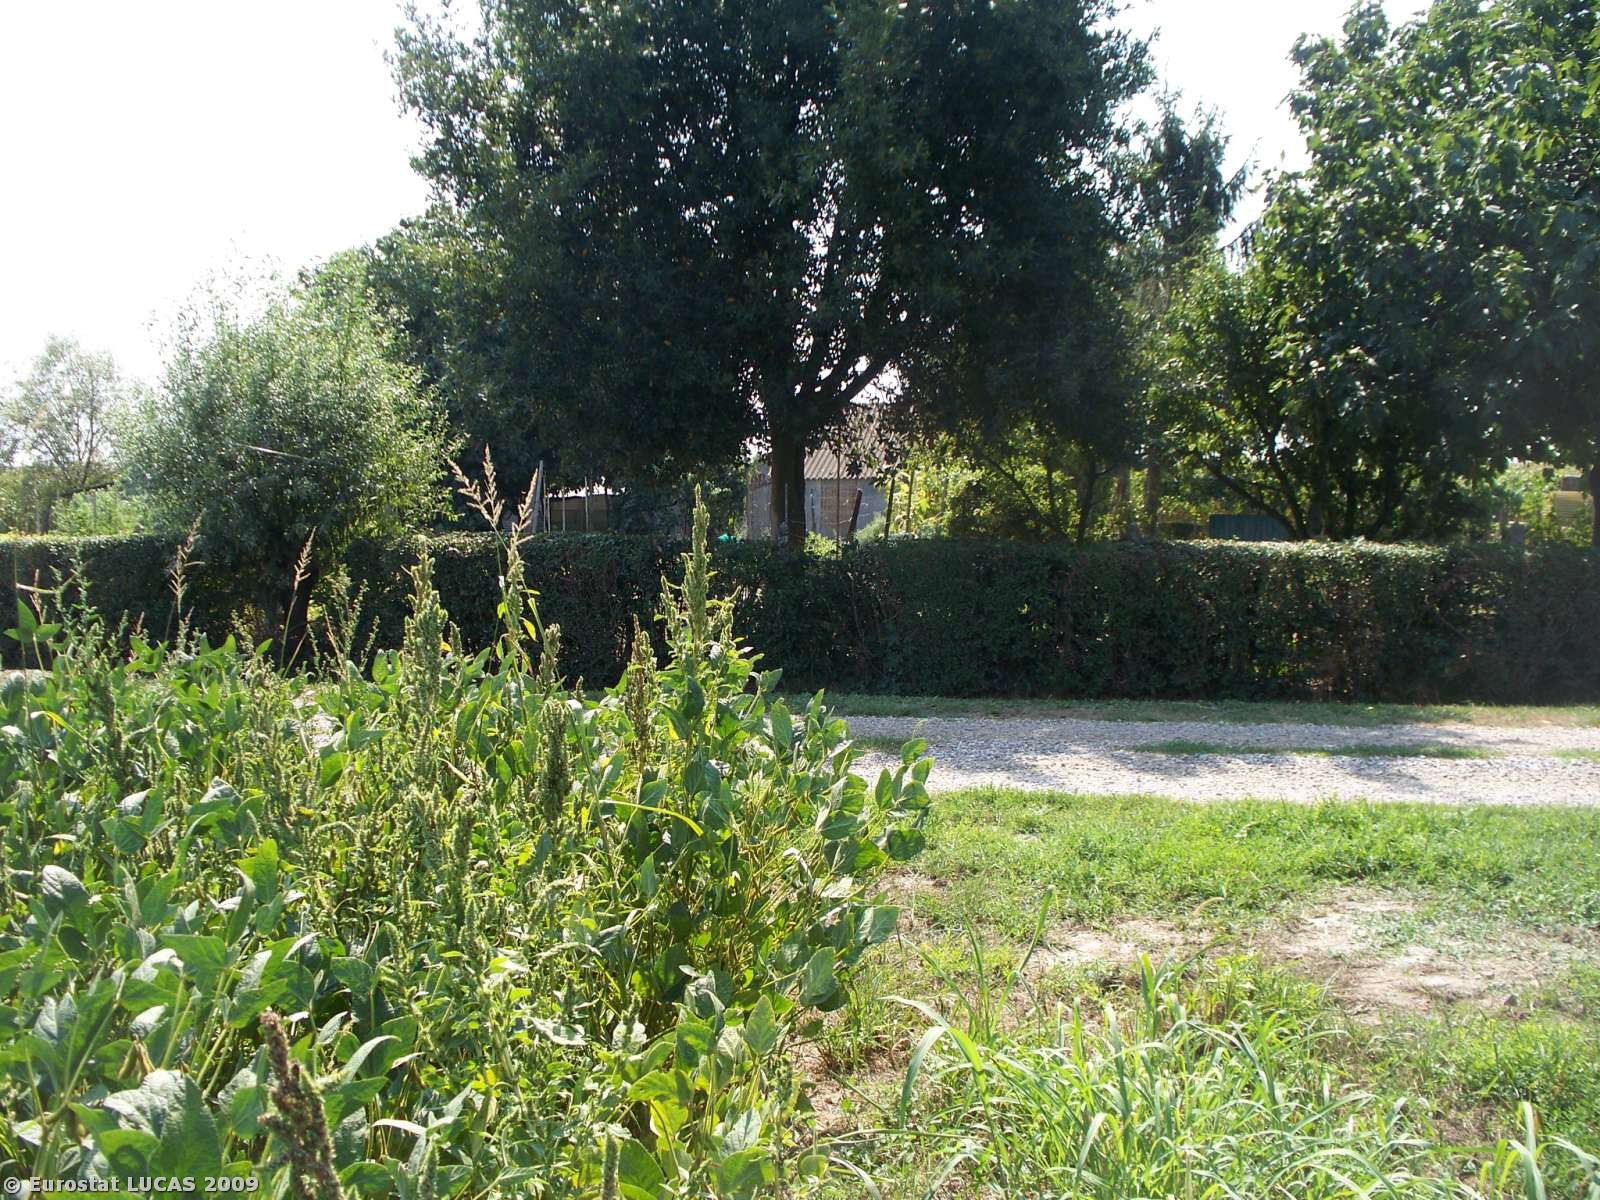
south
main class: Cropland
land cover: Soya
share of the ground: > 75 %
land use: Agriculture (excluding fallow land and kitchen gardens)
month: May
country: IT
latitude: 45.6613
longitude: 12.9607
